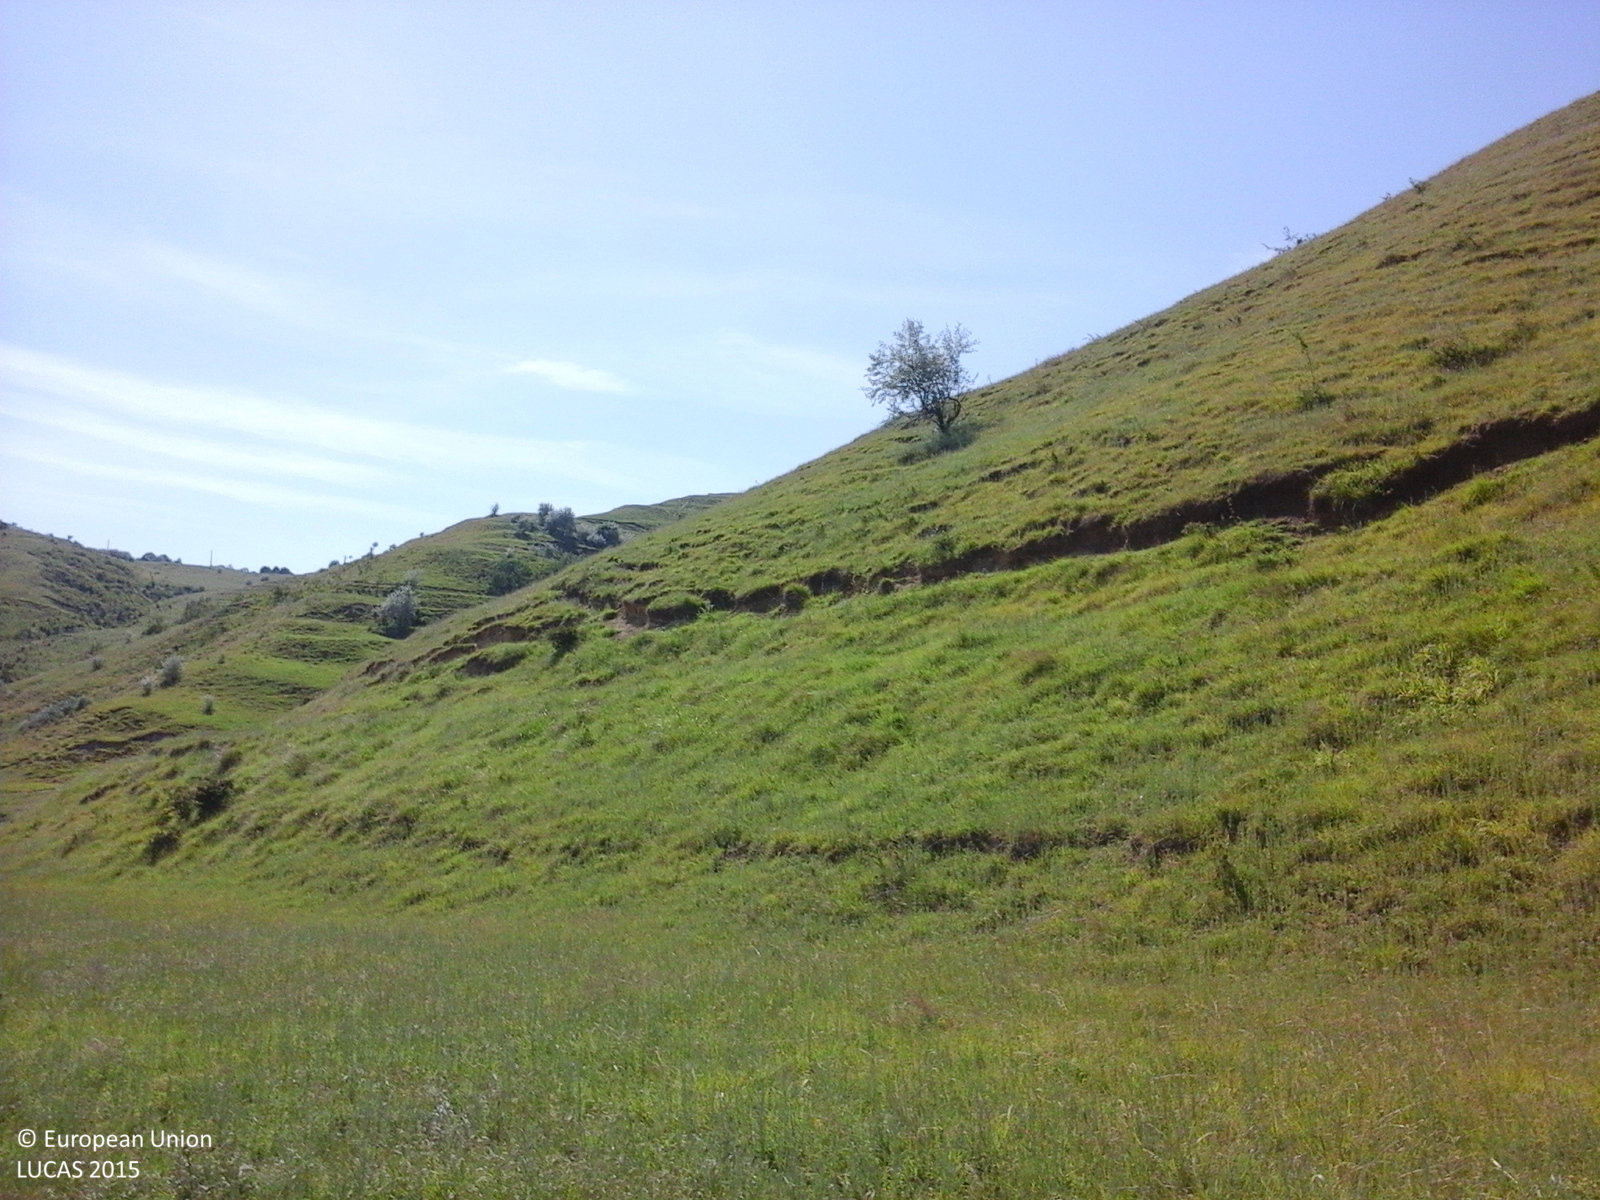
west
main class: Grassland
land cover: Grassland without tree/shrub cover
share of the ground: > 75 %
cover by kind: herbaceous plants 100 %
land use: Agriculture (excluding fallow land and kitchen gardens)
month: June
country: RO
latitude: 44.9941
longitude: 26.2100
